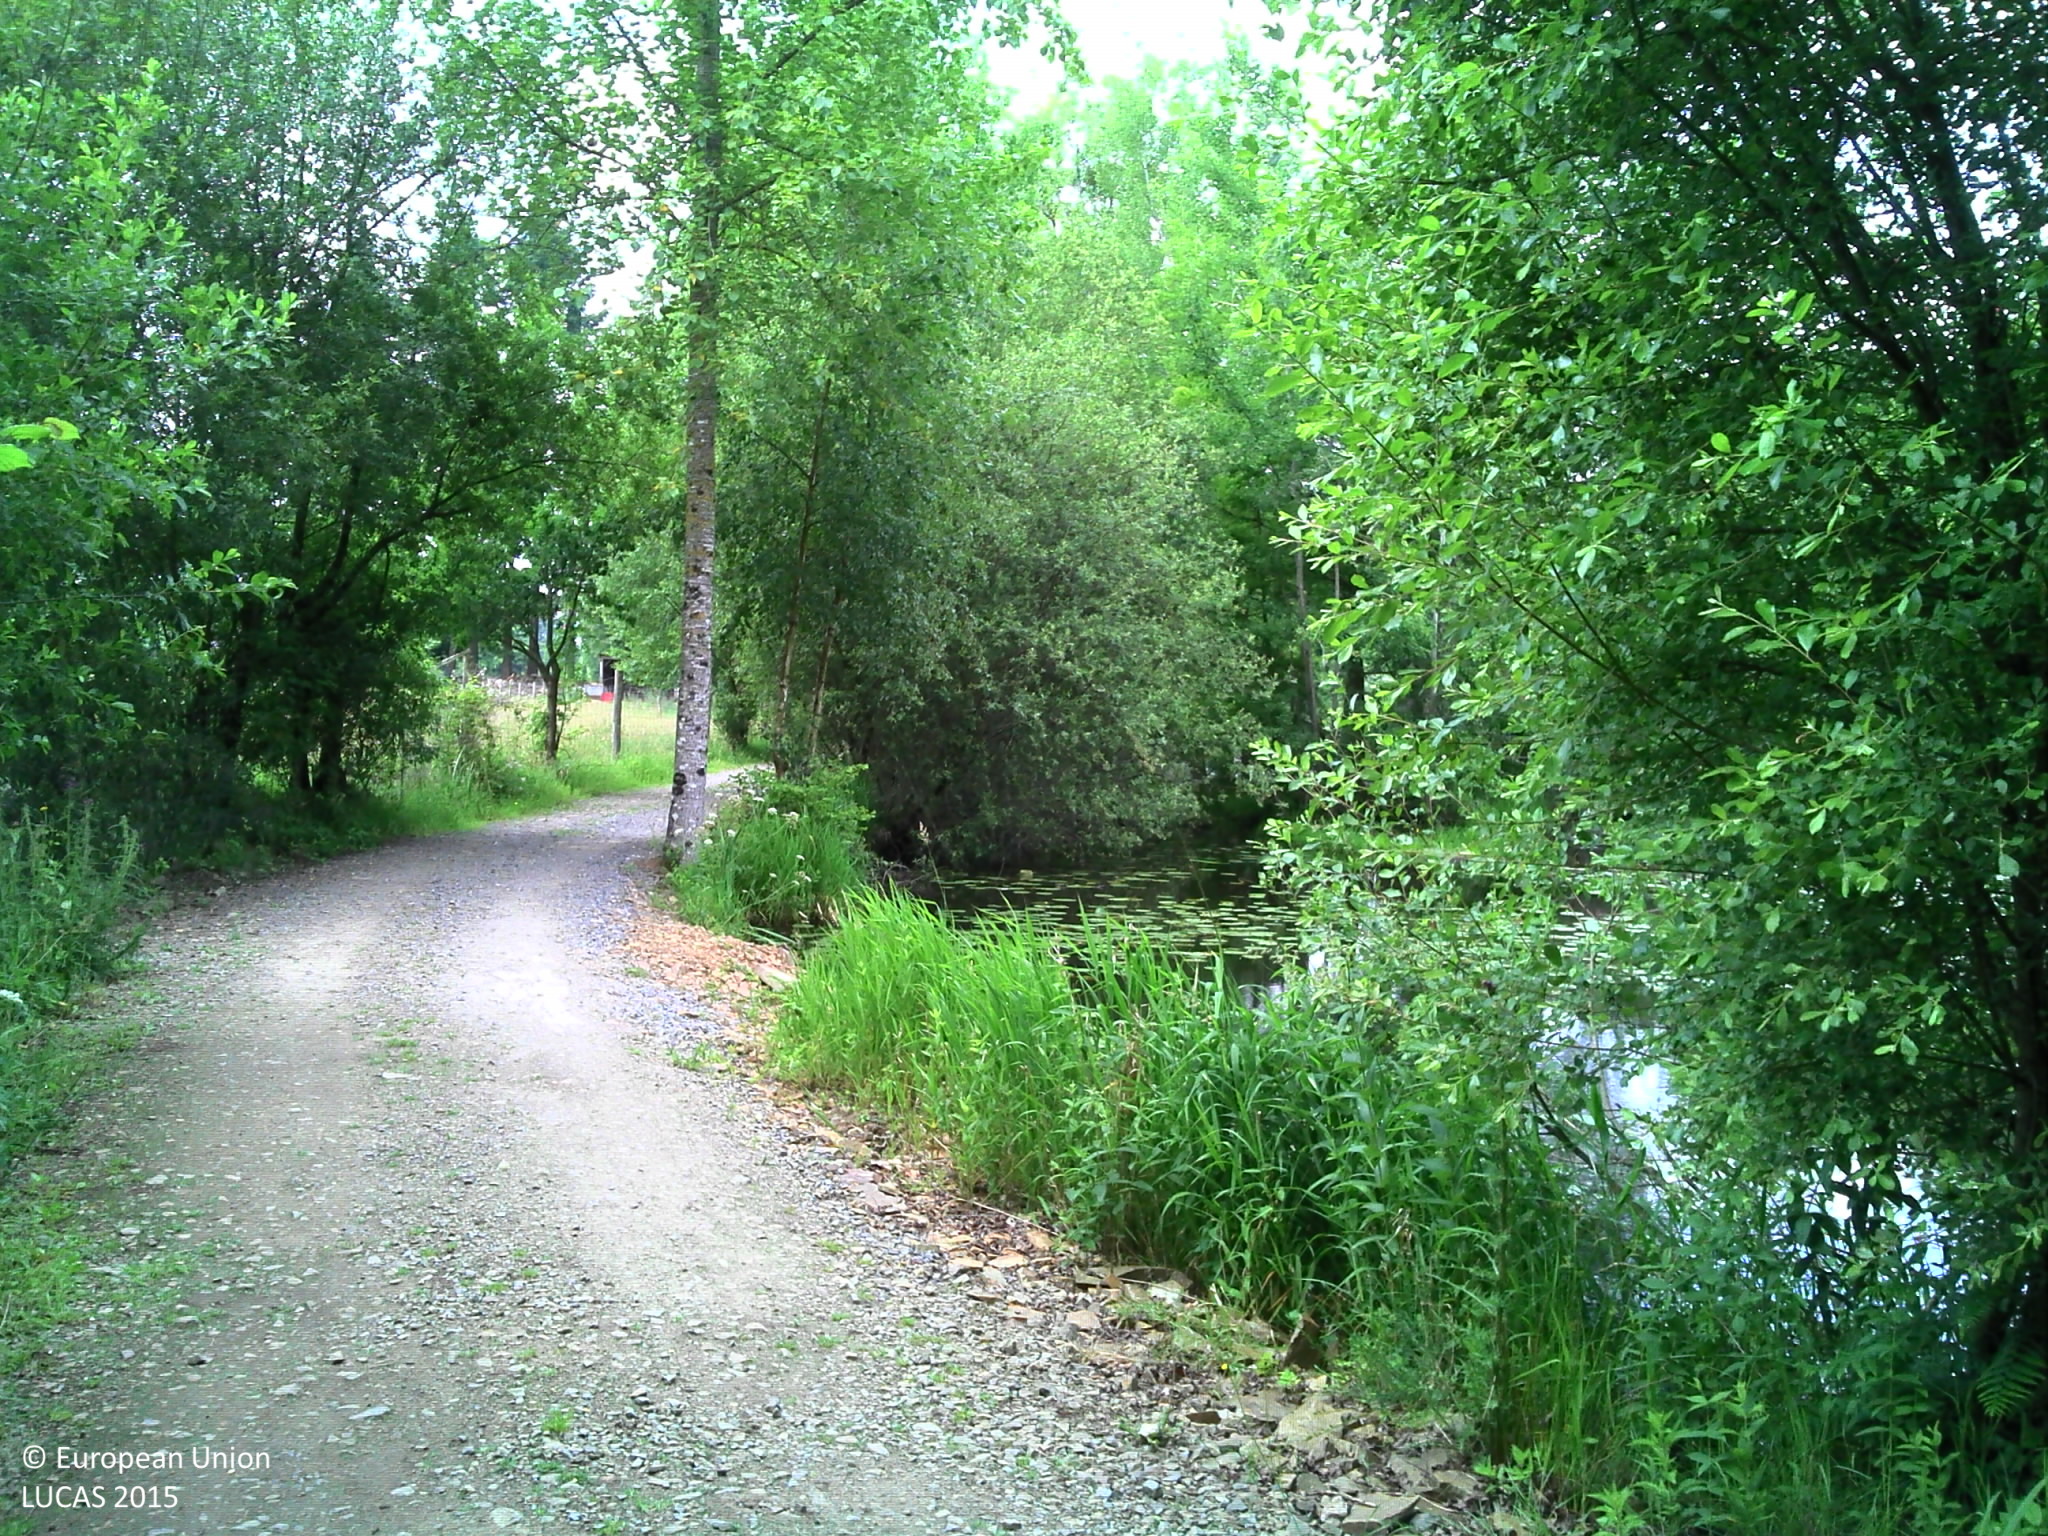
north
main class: Woodland
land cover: Spruce dominated mixed woodland
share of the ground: > 75 %
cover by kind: broadleaved forest trees 55 %, coniferous forest trees 40 %, herbaceous plants 5 %
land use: Semi-natural and natural areas not in use
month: June
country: FR
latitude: 48.4861
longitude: -1.7265
